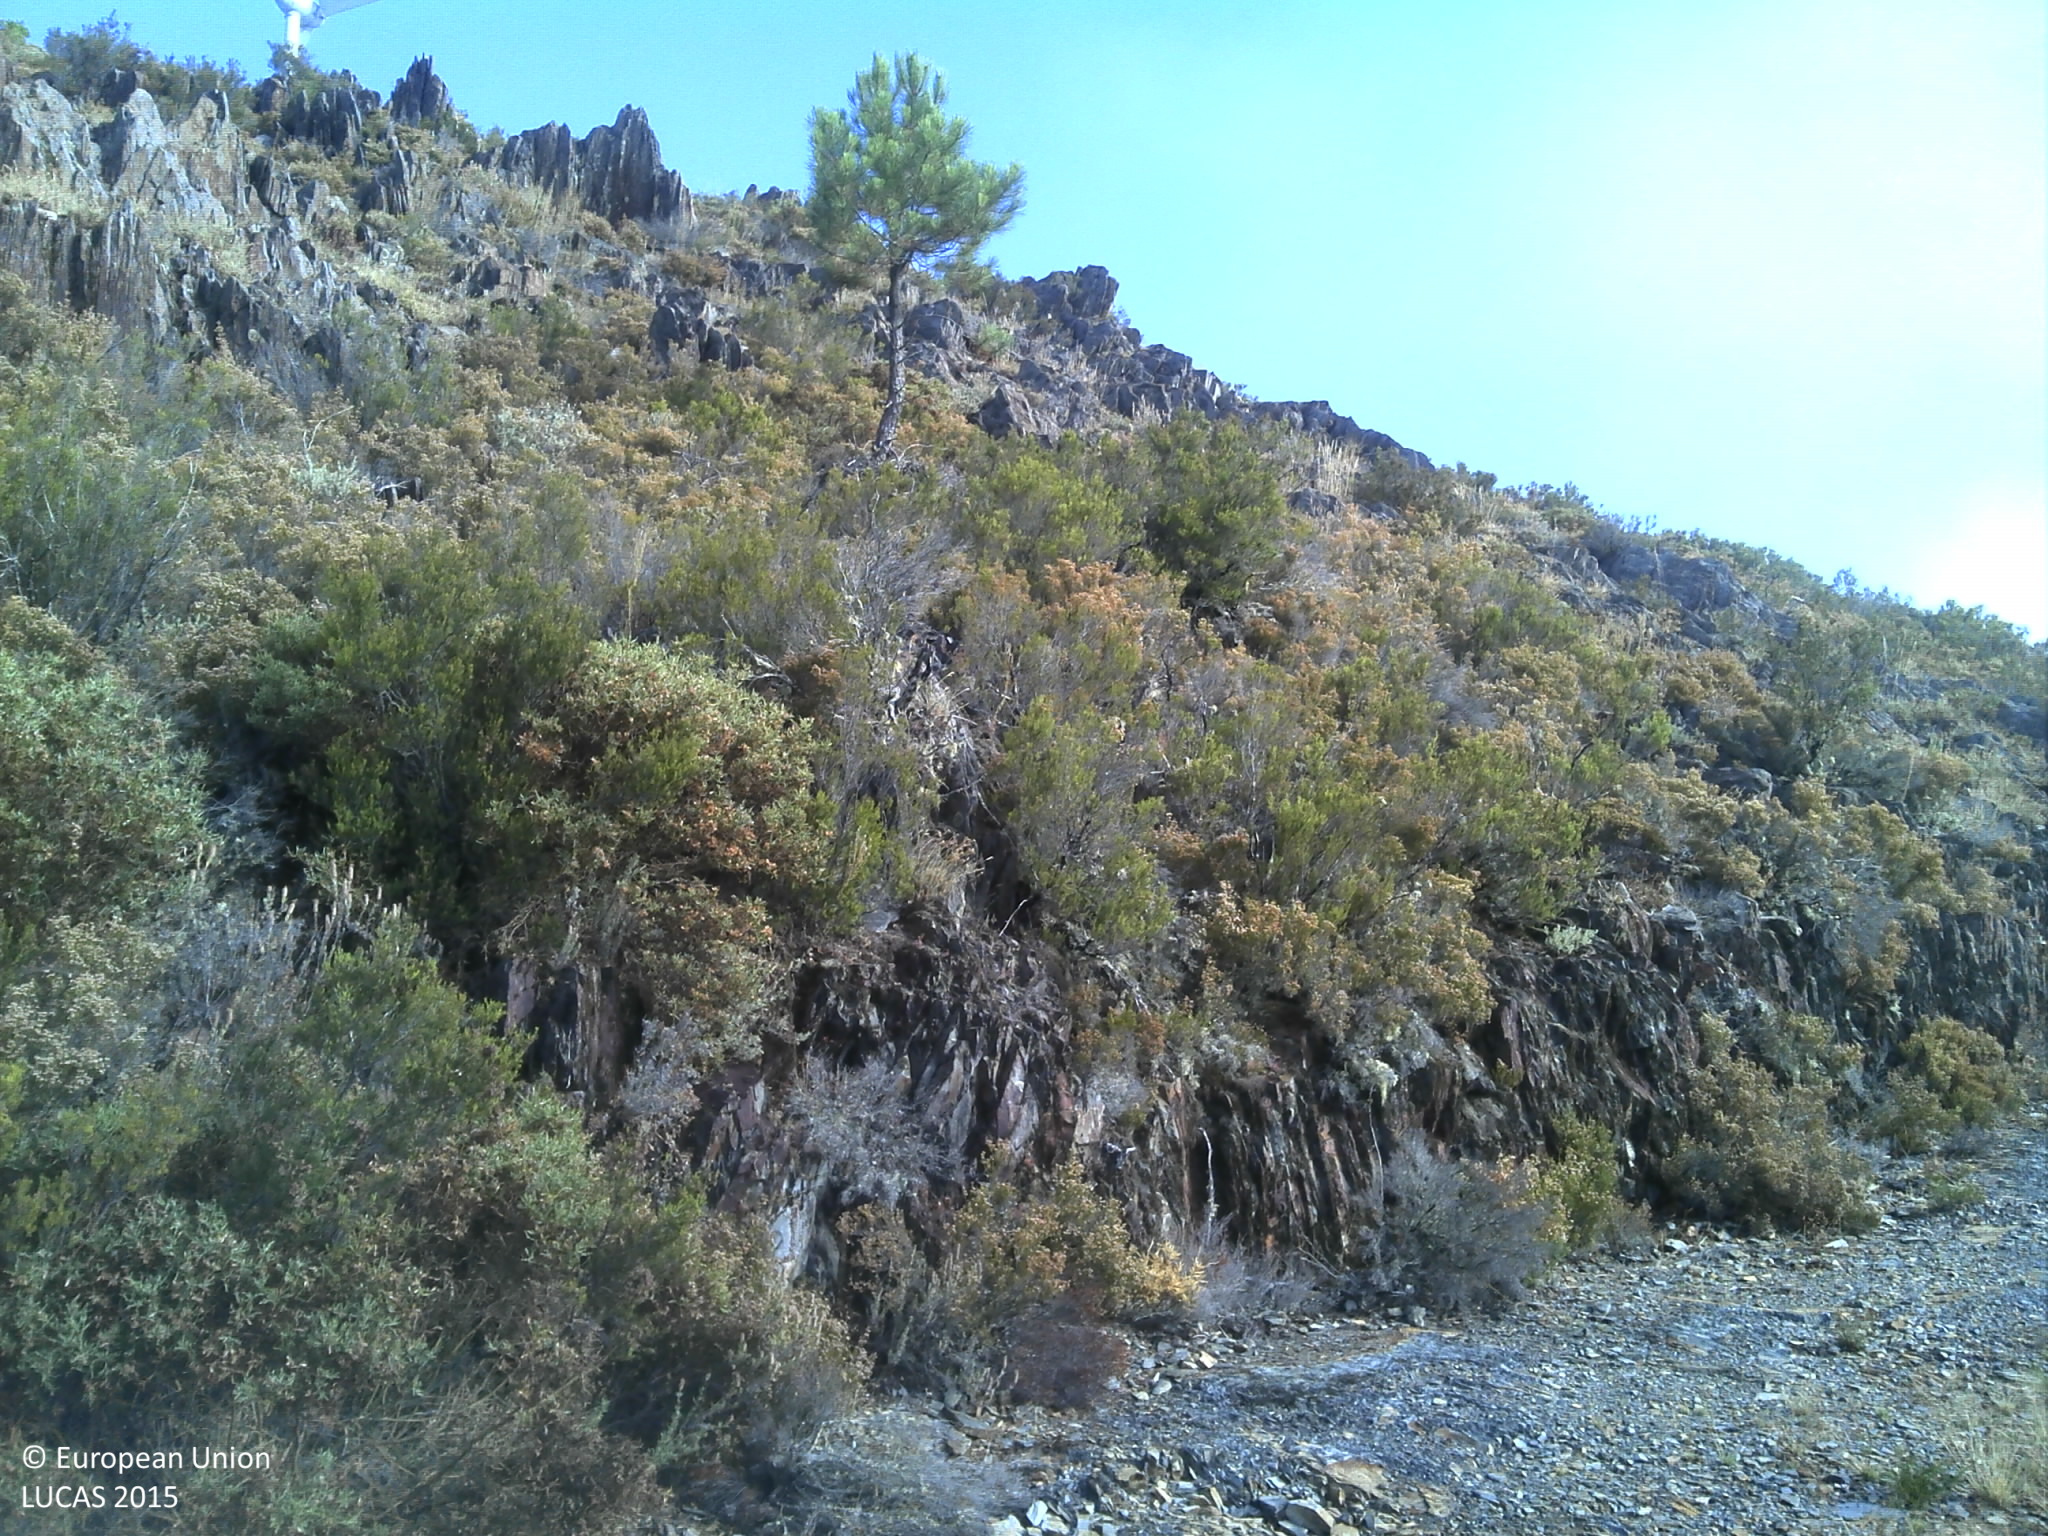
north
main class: Shrubland
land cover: Shrubland without tree cover
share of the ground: 50 - 75 %
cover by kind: shrubs 75 %, unconsolidated bare surface 25 %
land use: Semi-natural and natural areas not in use
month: July
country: PT
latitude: 40.2445
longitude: -7.8303
